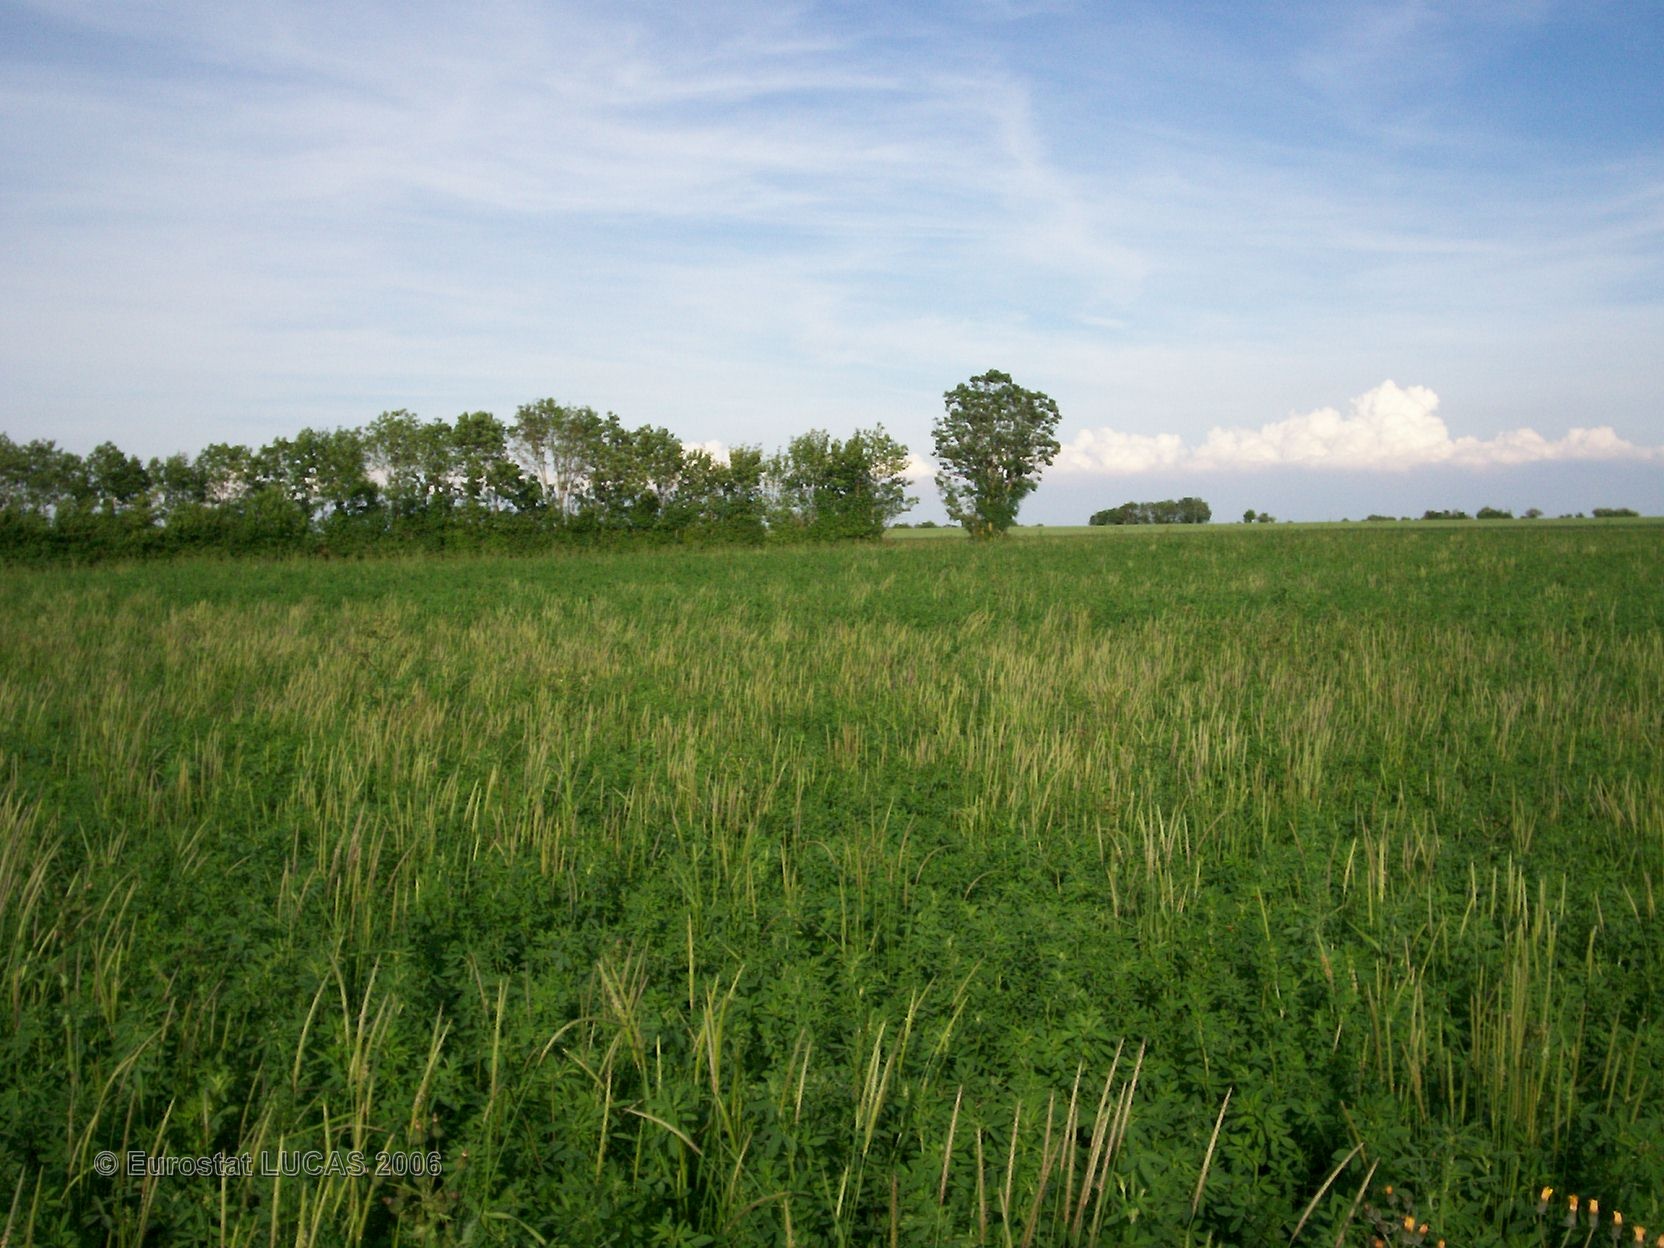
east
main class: Cropland
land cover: Lucerne
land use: Agriculture (excluding fallow land and kitchen gardens)
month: May
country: FR
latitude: 46.1540
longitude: -0.1863
